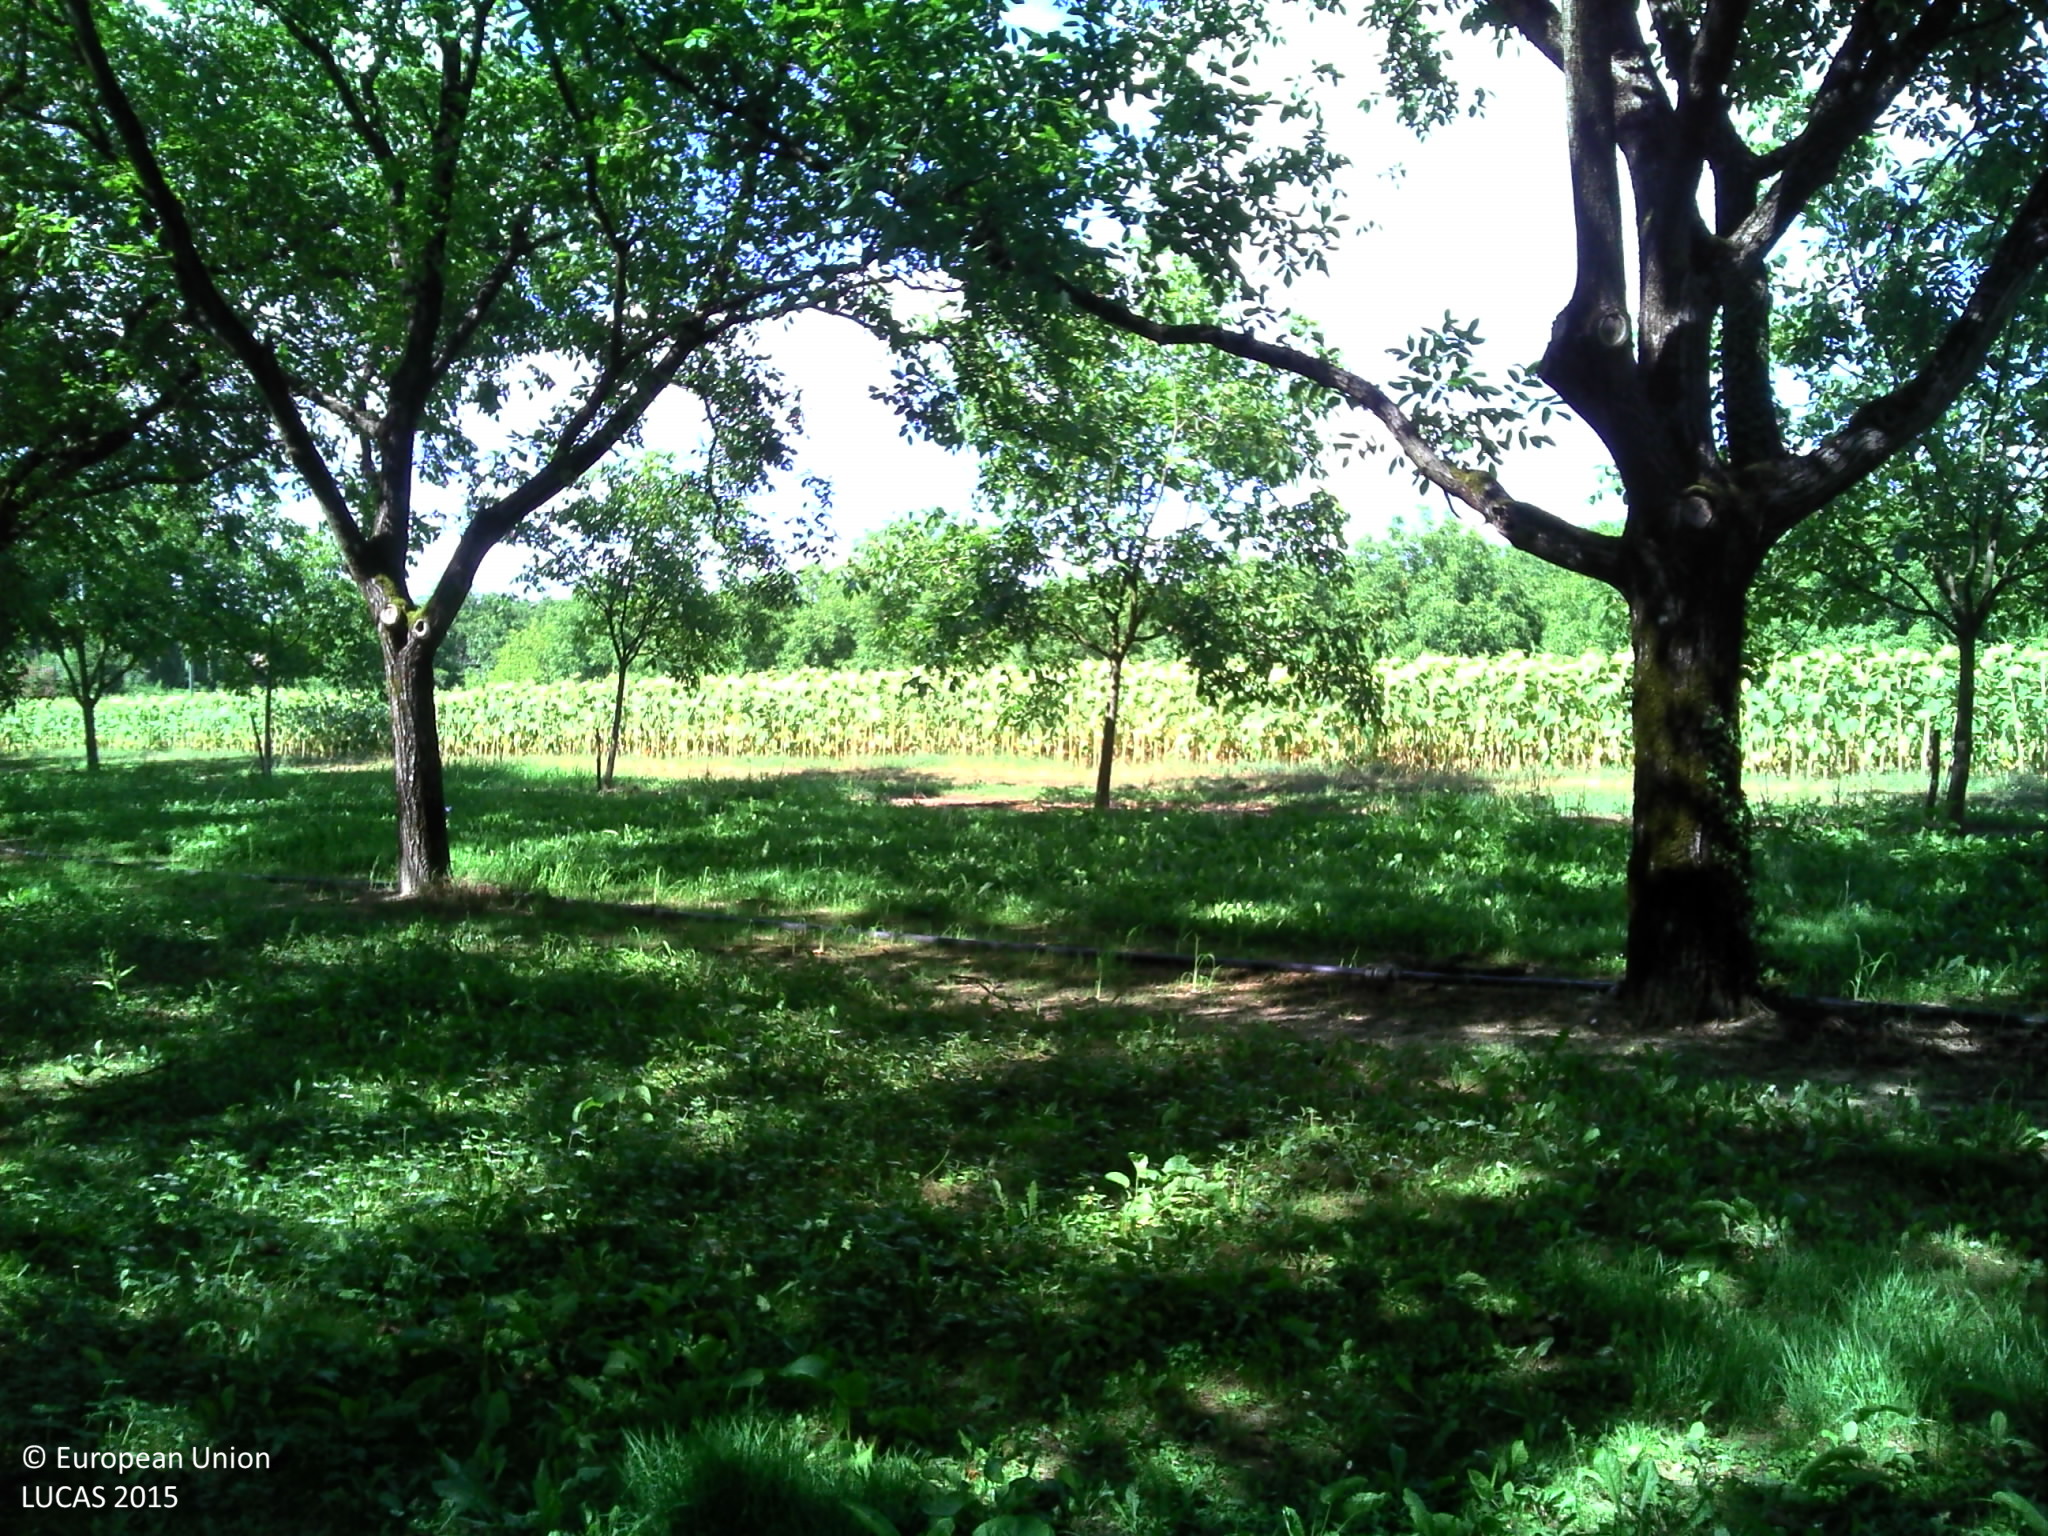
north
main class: Cropland
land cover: Nuts trees
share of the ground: 25 - 50 %
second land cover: Grassland without tree/shrub cover
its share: 50 - 75 %
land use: Agriculture (excluding fallow land and kitchen gardens)
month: July
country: FR
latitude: 45.0745
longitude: 5.2930
